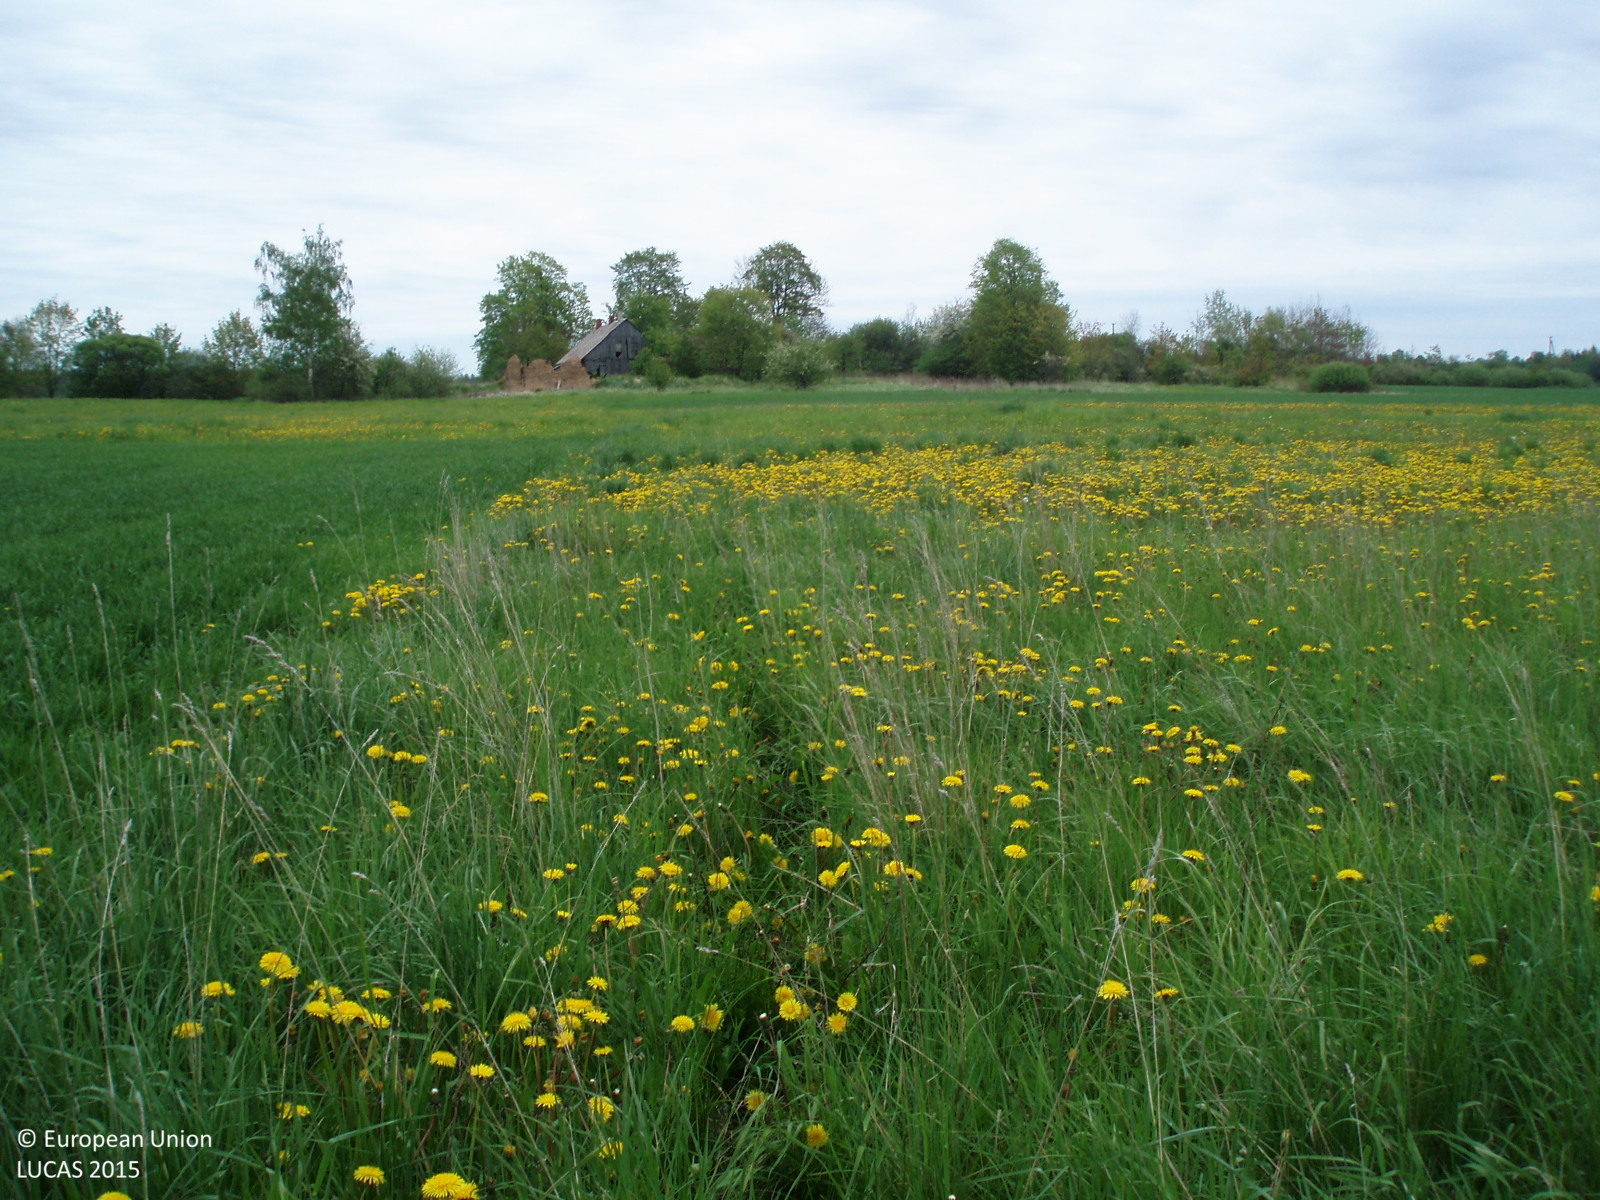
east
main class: Grassland
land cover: Grassland without tree/shrub cover
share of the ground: > 75 %
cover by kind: herbaceous plants 100 %
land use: Agriculture (excluding fallow land and kitchen gardens)
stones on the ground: < 10 %
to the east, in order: Grassland without tree/shrub cover; Common wheat; Grassland without tree/shrub cover; Broadleaved woodland; Grassland without tree/shrub cover; Artificial constructions in urban areas; Grassland with sparse tree/shrub cover; Grassland without tree/shrub cover
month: May
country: LT
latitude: 56.3483
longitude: 22.4022
